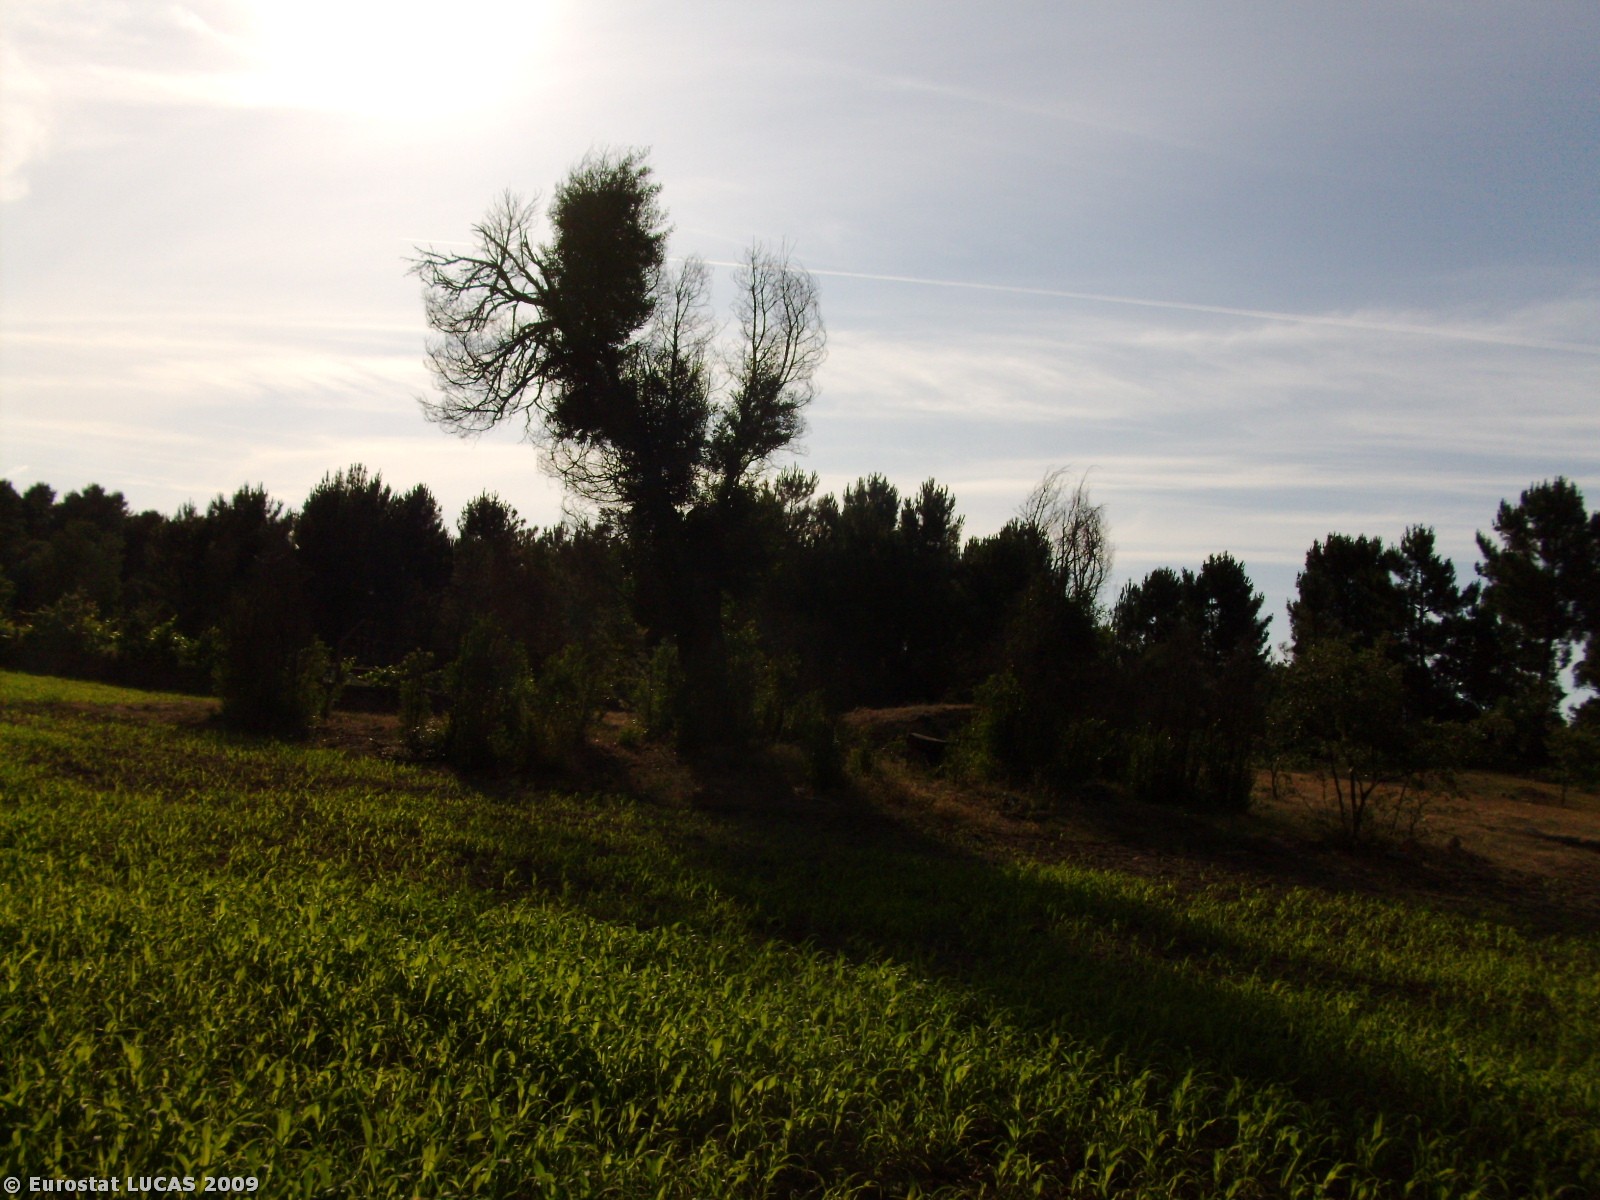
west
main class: Cropland
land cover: Maize
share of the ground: > 75 %
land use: Agriculture (excluding fallow land and kitchen gardens)
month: July
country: PT
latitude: 40.6108
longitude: -7.6445
